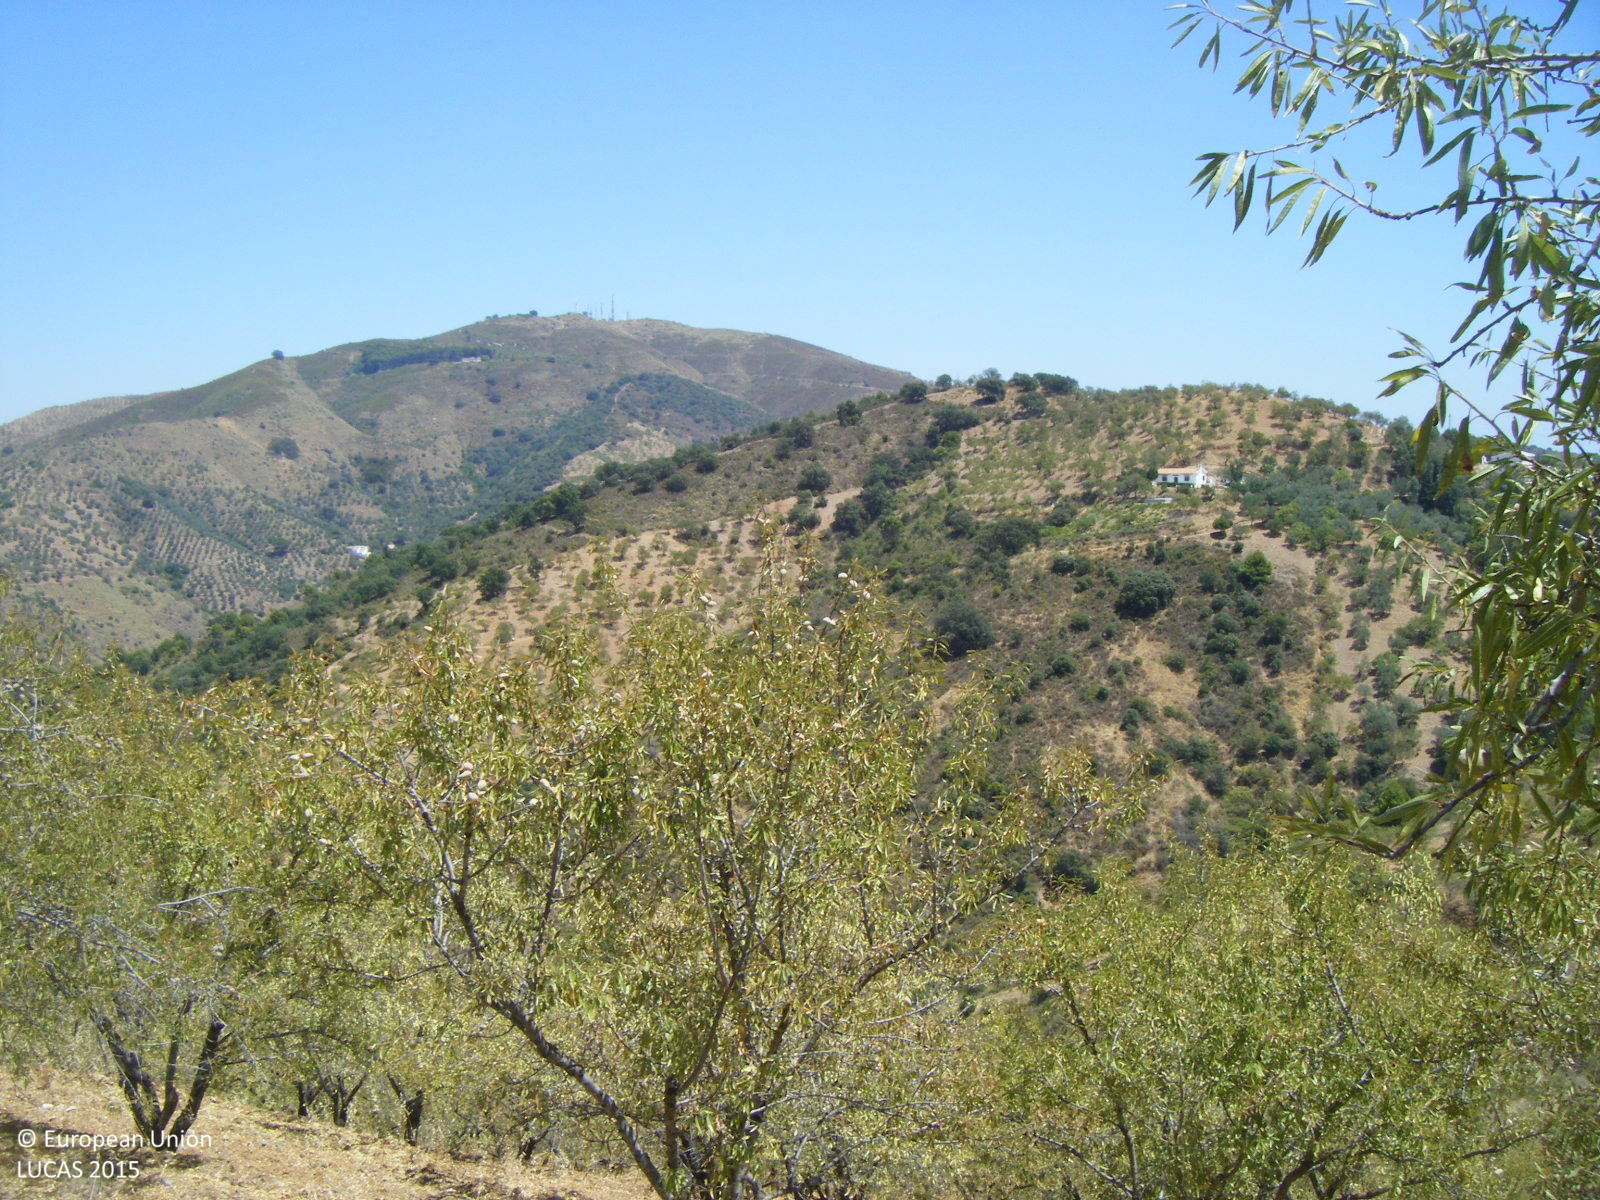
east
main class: Cropland
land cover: Nuts trees
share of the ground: 10 - 25 %
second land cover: Spontaneously vegetated surfaces
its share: > 75 %
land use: Agriculture (excluding fallow land and kitchen gardens)
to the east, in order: Nuts trees; Spontaneously vegetated surfaces; Shrubland without tree cover; Rivers and streams
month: July
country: ES
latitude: 36.8039
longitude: -4.3257
